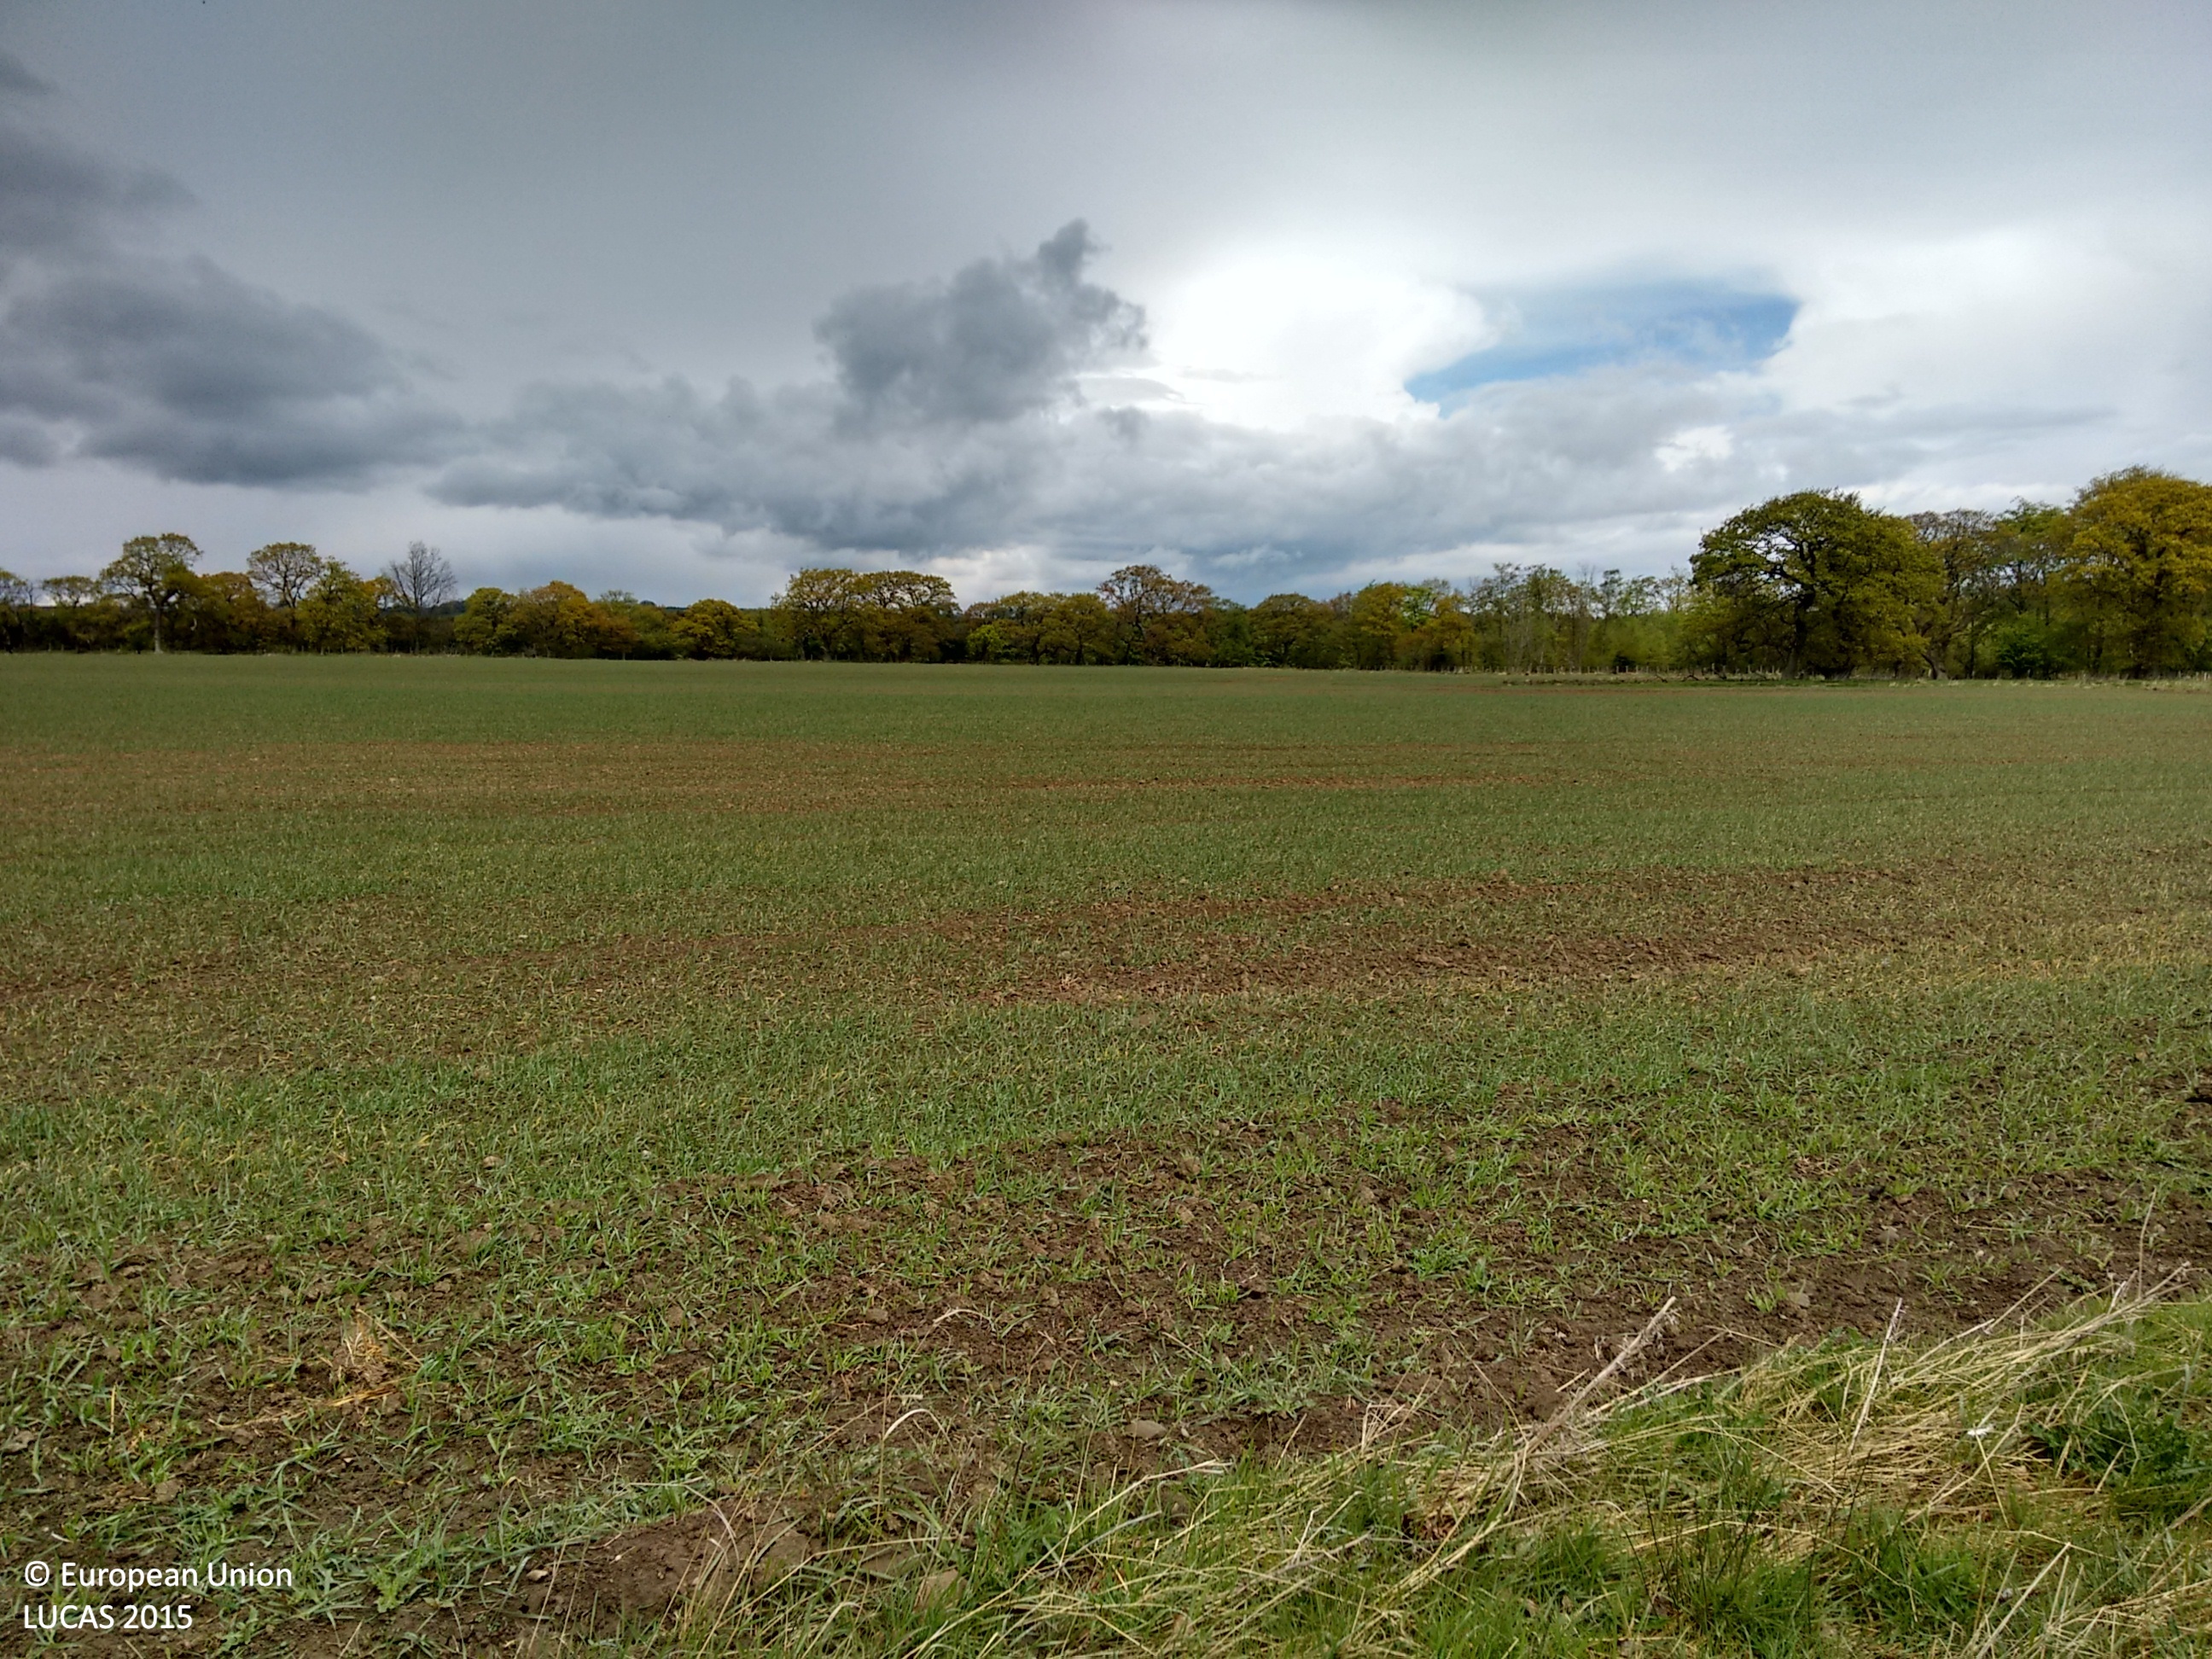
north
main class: Grassland
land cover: Grassland with sparse tree/shrub cover
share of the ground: > 75 %
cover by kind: herbaceous plants 95 %, broadleaved forest trees 5 %
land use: Agriculture (excluding fallow land and kitchen gardens)
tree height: > 5 m
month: May
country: GB
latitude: 55.3765
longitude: -1.7116
